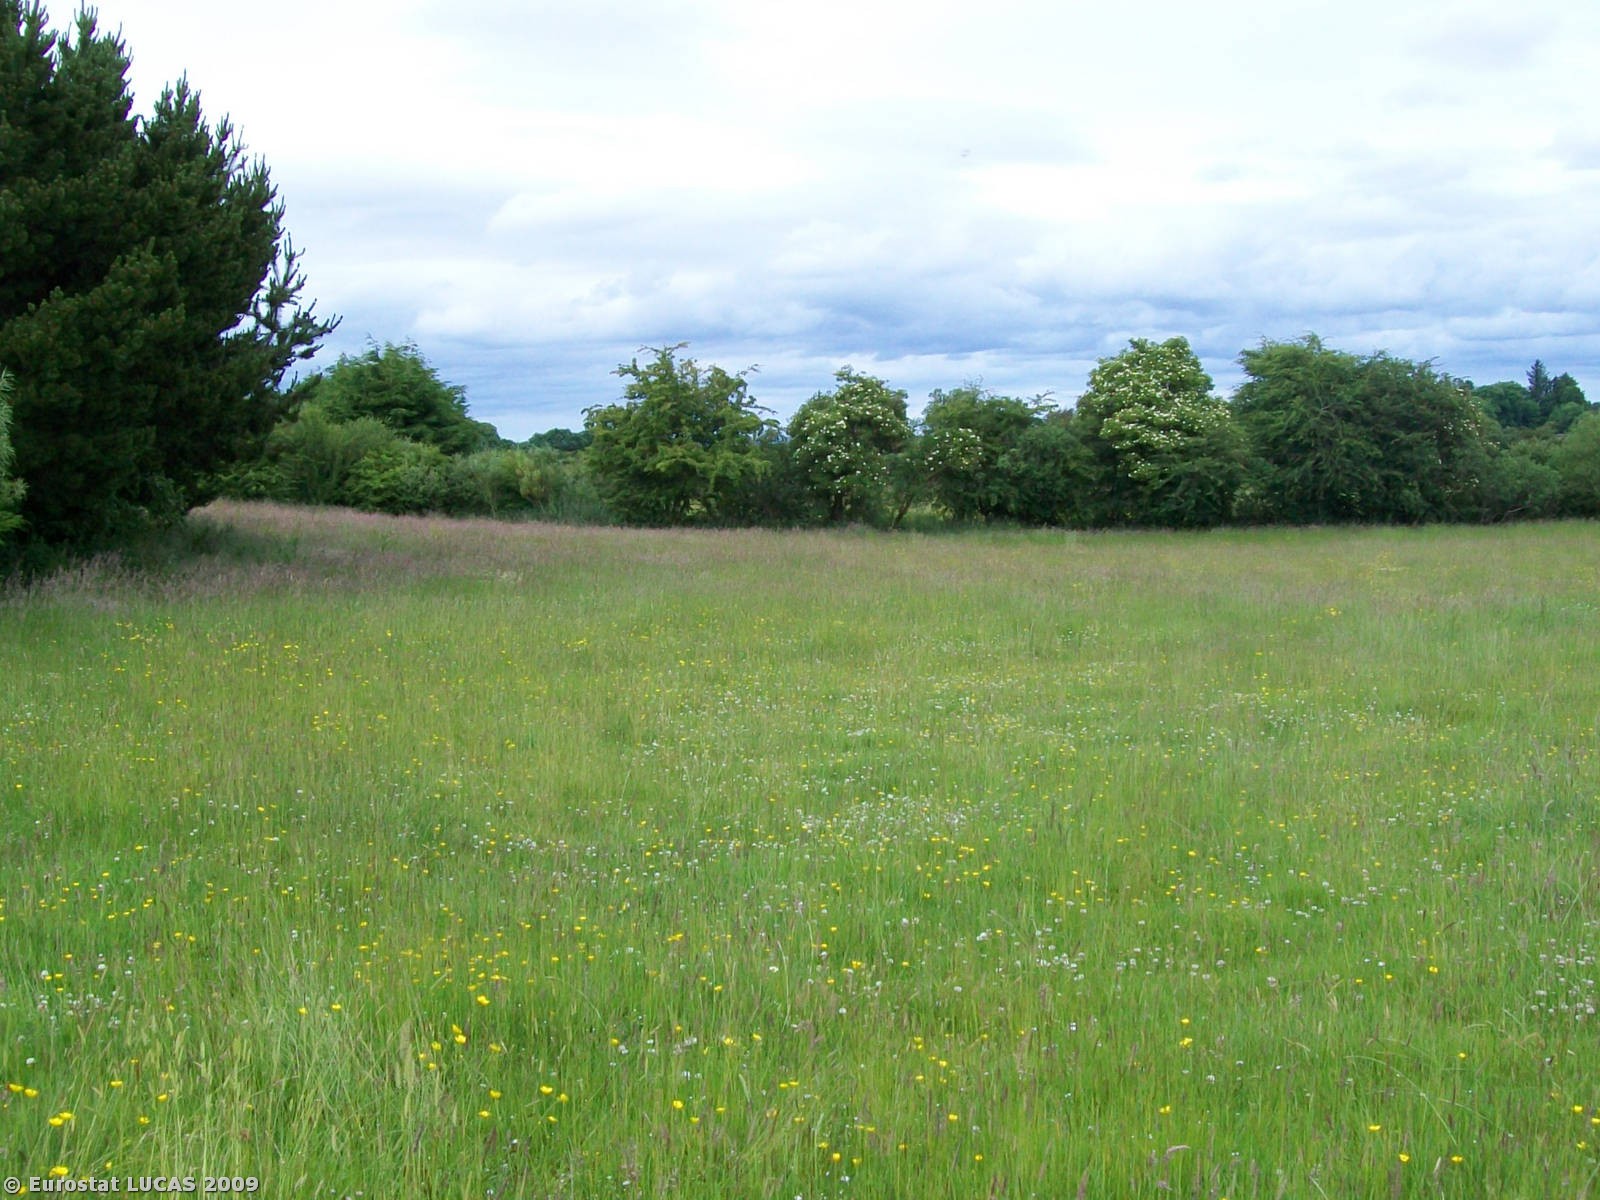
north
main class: Grassland
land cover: Grassland without tree/shrub cover
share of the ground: > 75 %
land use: Agriculture (excluding fallow land and kitchen gardens)
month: June
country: IE
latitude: 53.7808
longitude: -9.0156
